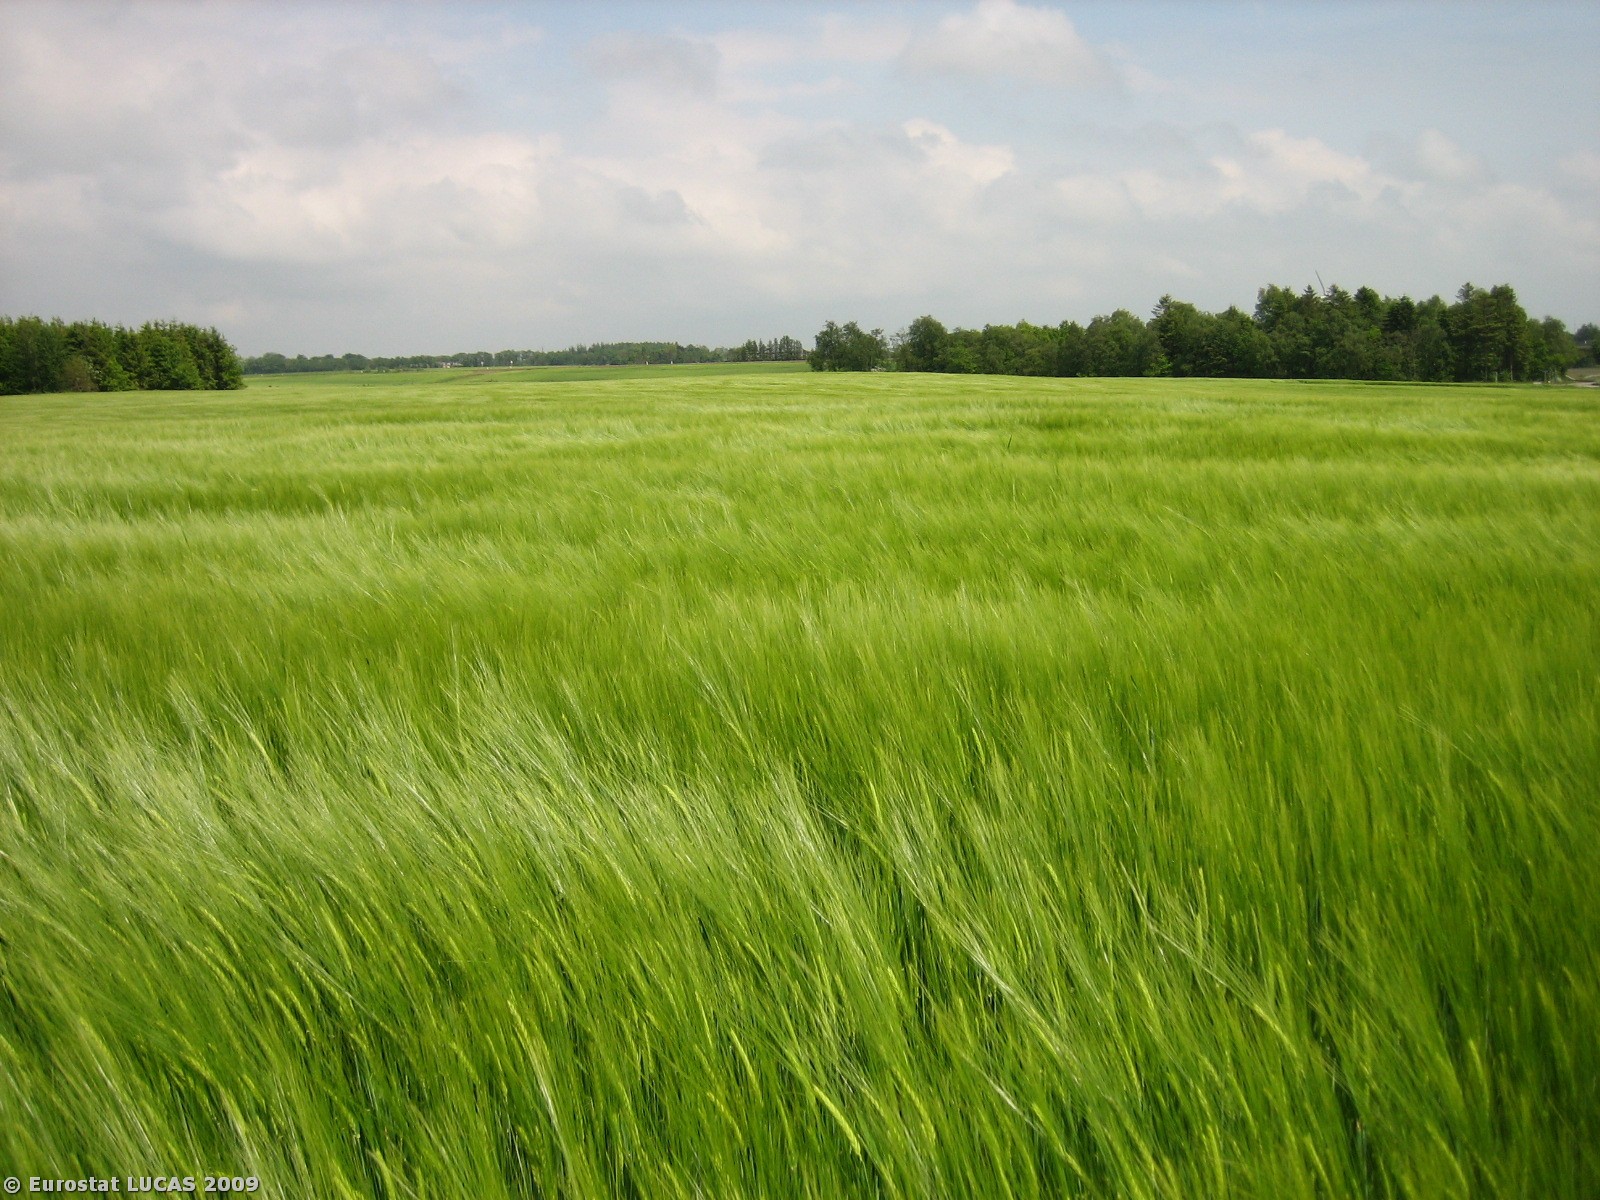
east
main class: Cropland
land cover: Barley
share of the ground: > 75 %
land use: Agriculture (excluding fallow land and kitchen gardens)
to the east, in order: Barley
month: May
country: DK
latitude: 55.8079
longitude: 9.2190
